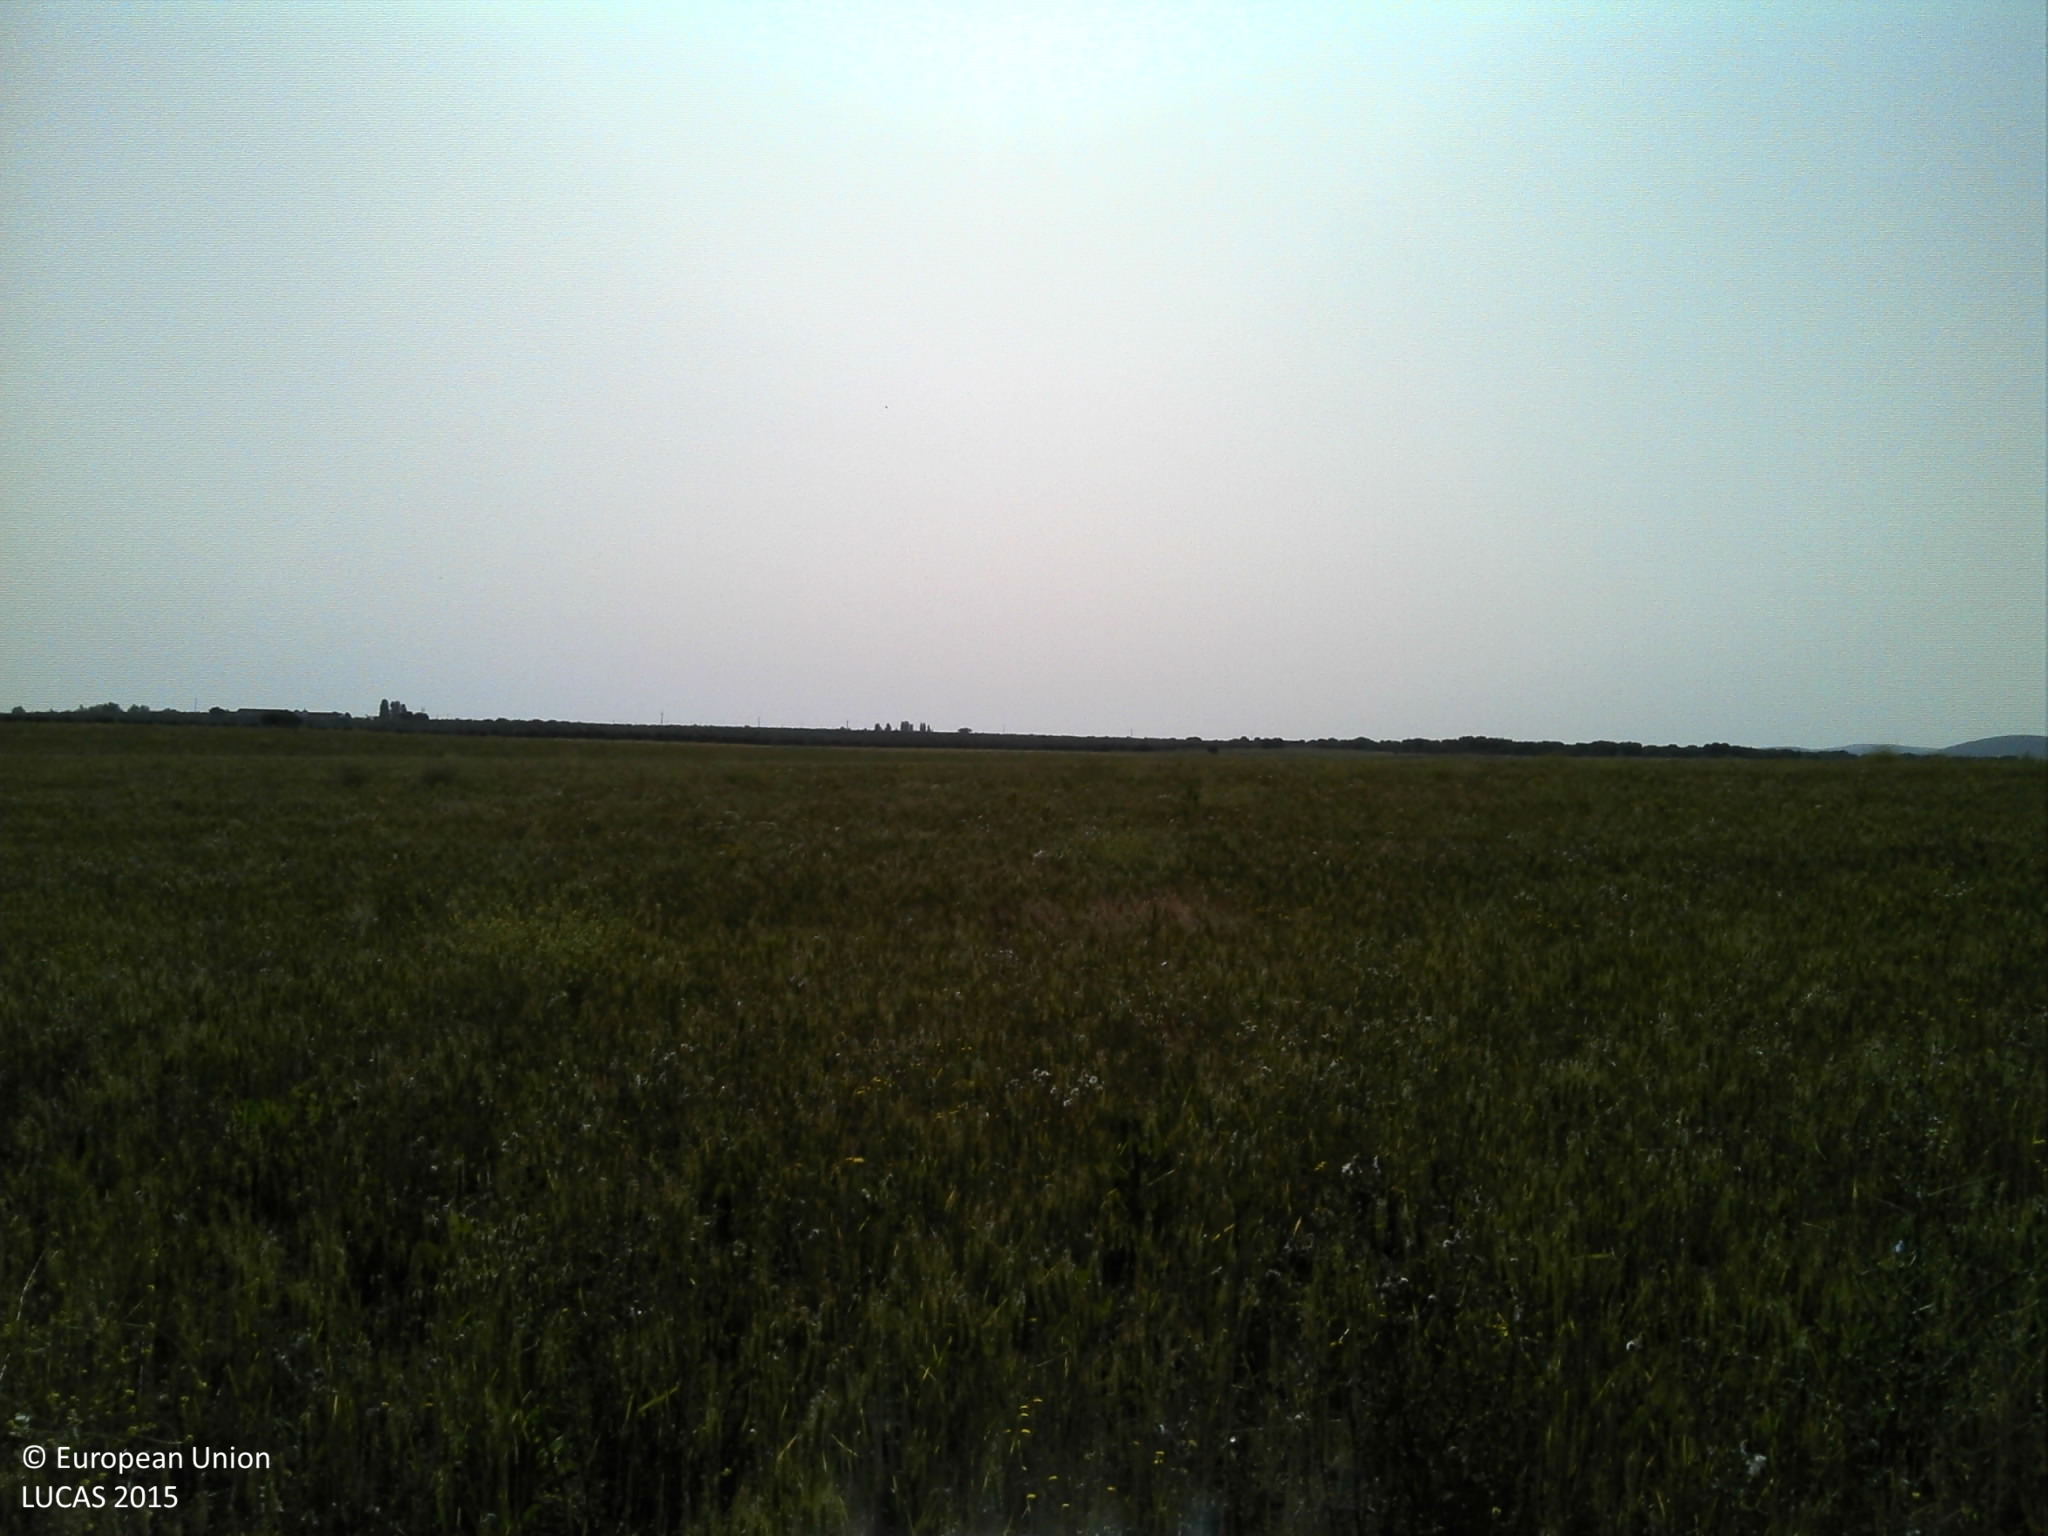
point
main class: Cropland
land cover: Mixed cereals for fodder
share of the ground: > 75 %
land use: Agriculture (excluding fallow land and kitchen gardens)
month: May
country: PT
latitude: 38.9784
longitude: -7.7861
